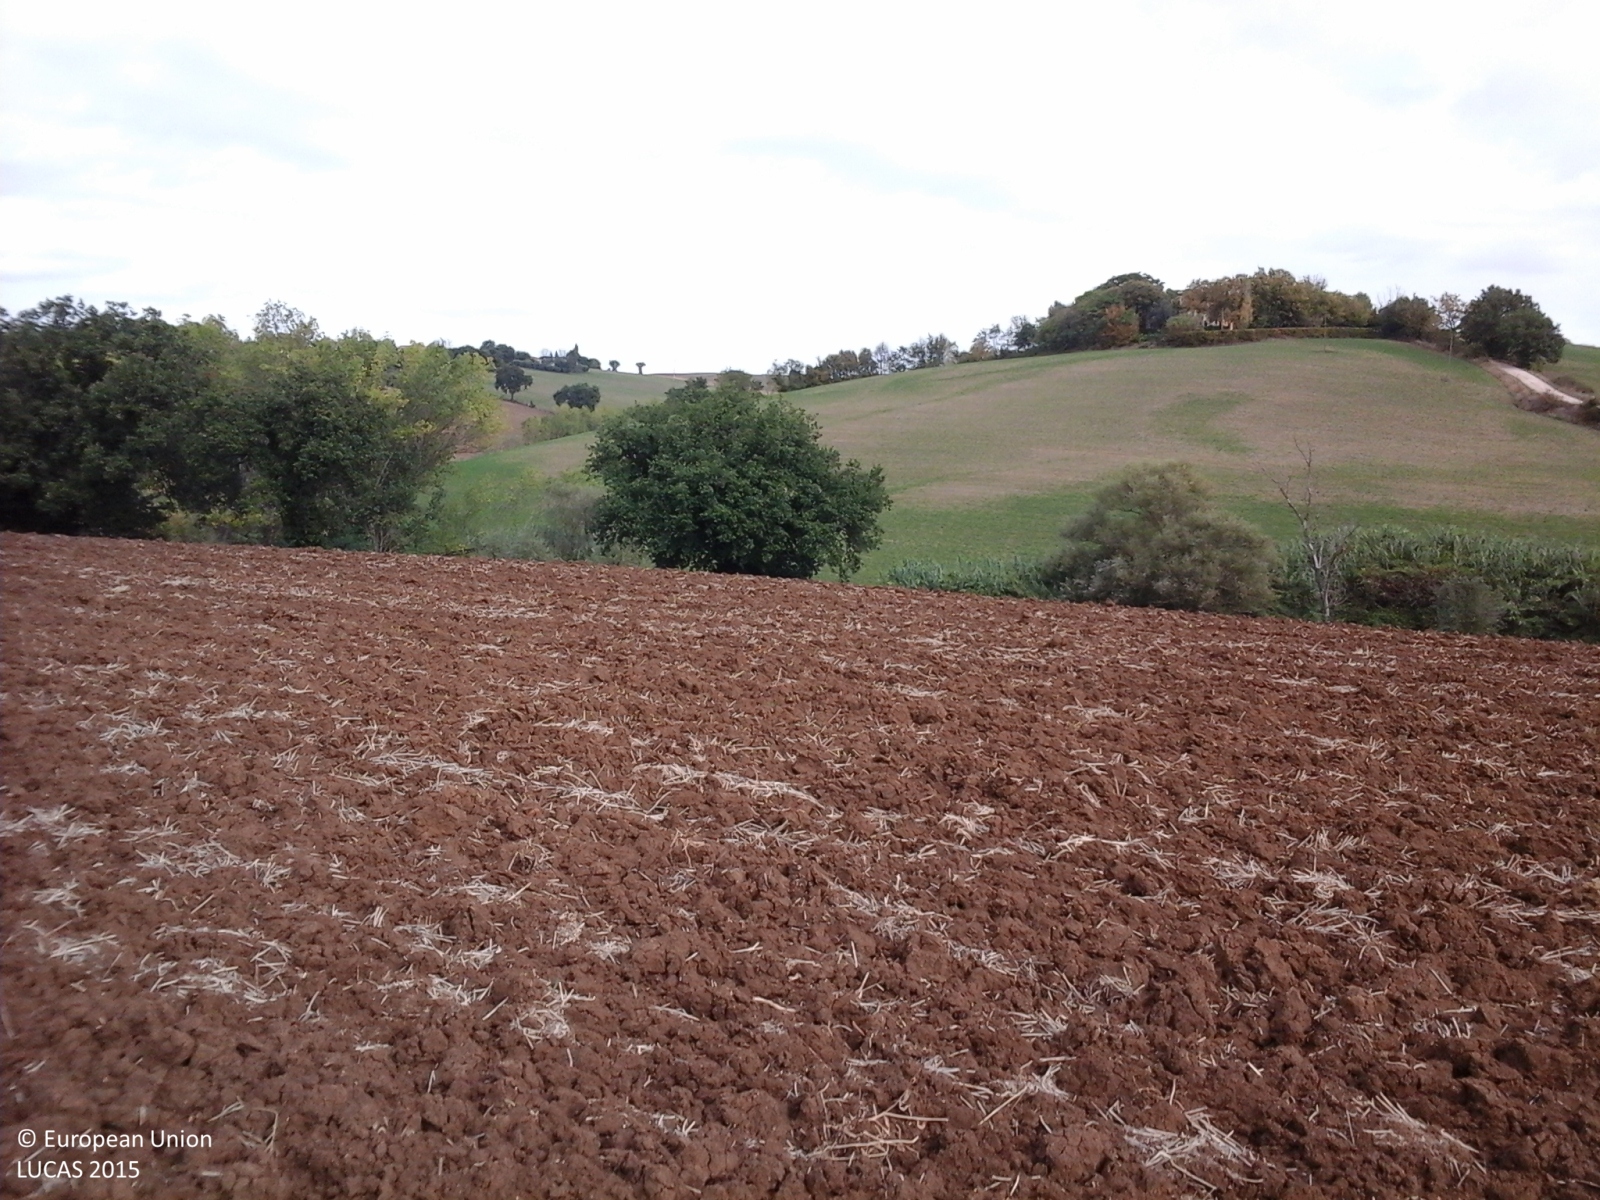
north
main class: Cropland
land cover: Common wheat
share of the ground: < 10 %
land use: Agriculture (excluding fallow land and kitchen gardens)
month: September
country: IT
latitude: 43.6031
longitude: 13.0030
